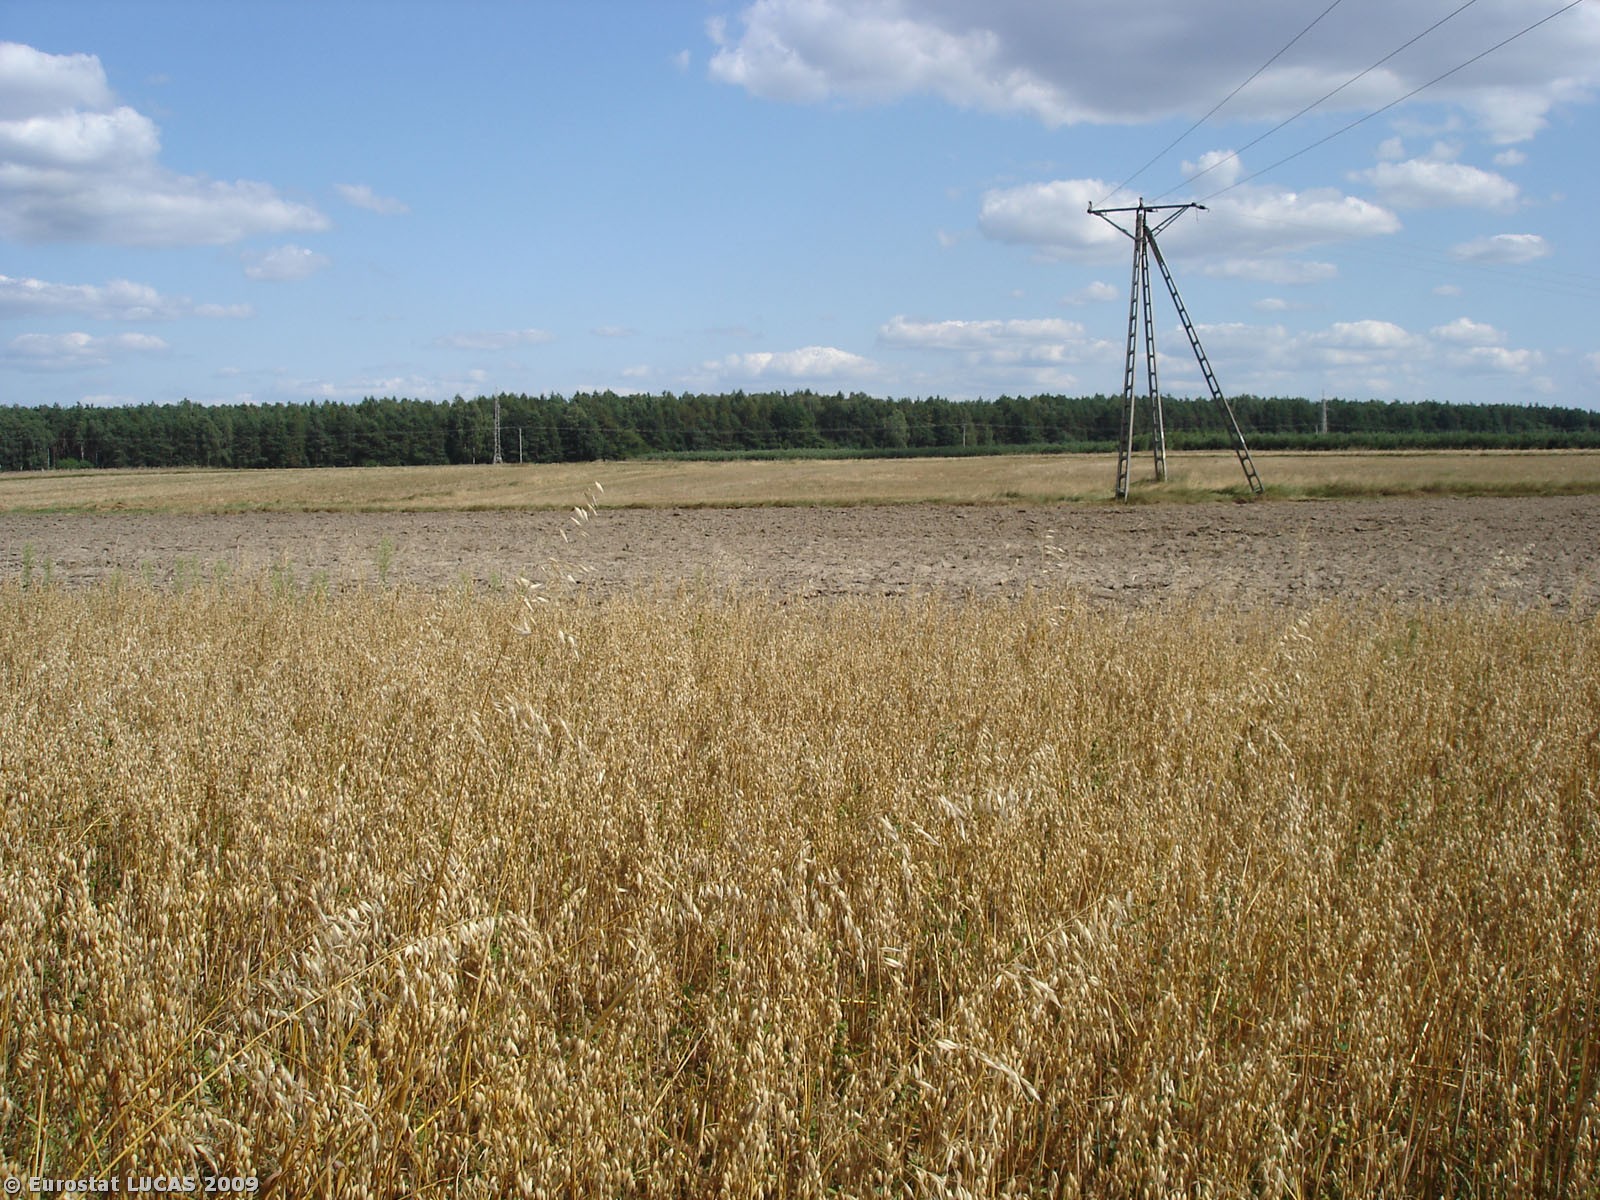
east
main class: Cropland
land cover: Oats
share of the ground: > 75 %
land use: Agriculture (excluding fallow land and kitchen gardens)
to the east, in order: Oats; Rye; Grass margins; Rye; Grass margins; Tracks; Grass margins; Rye
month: August
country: PL
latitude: 50.9779
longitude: 18.8671
